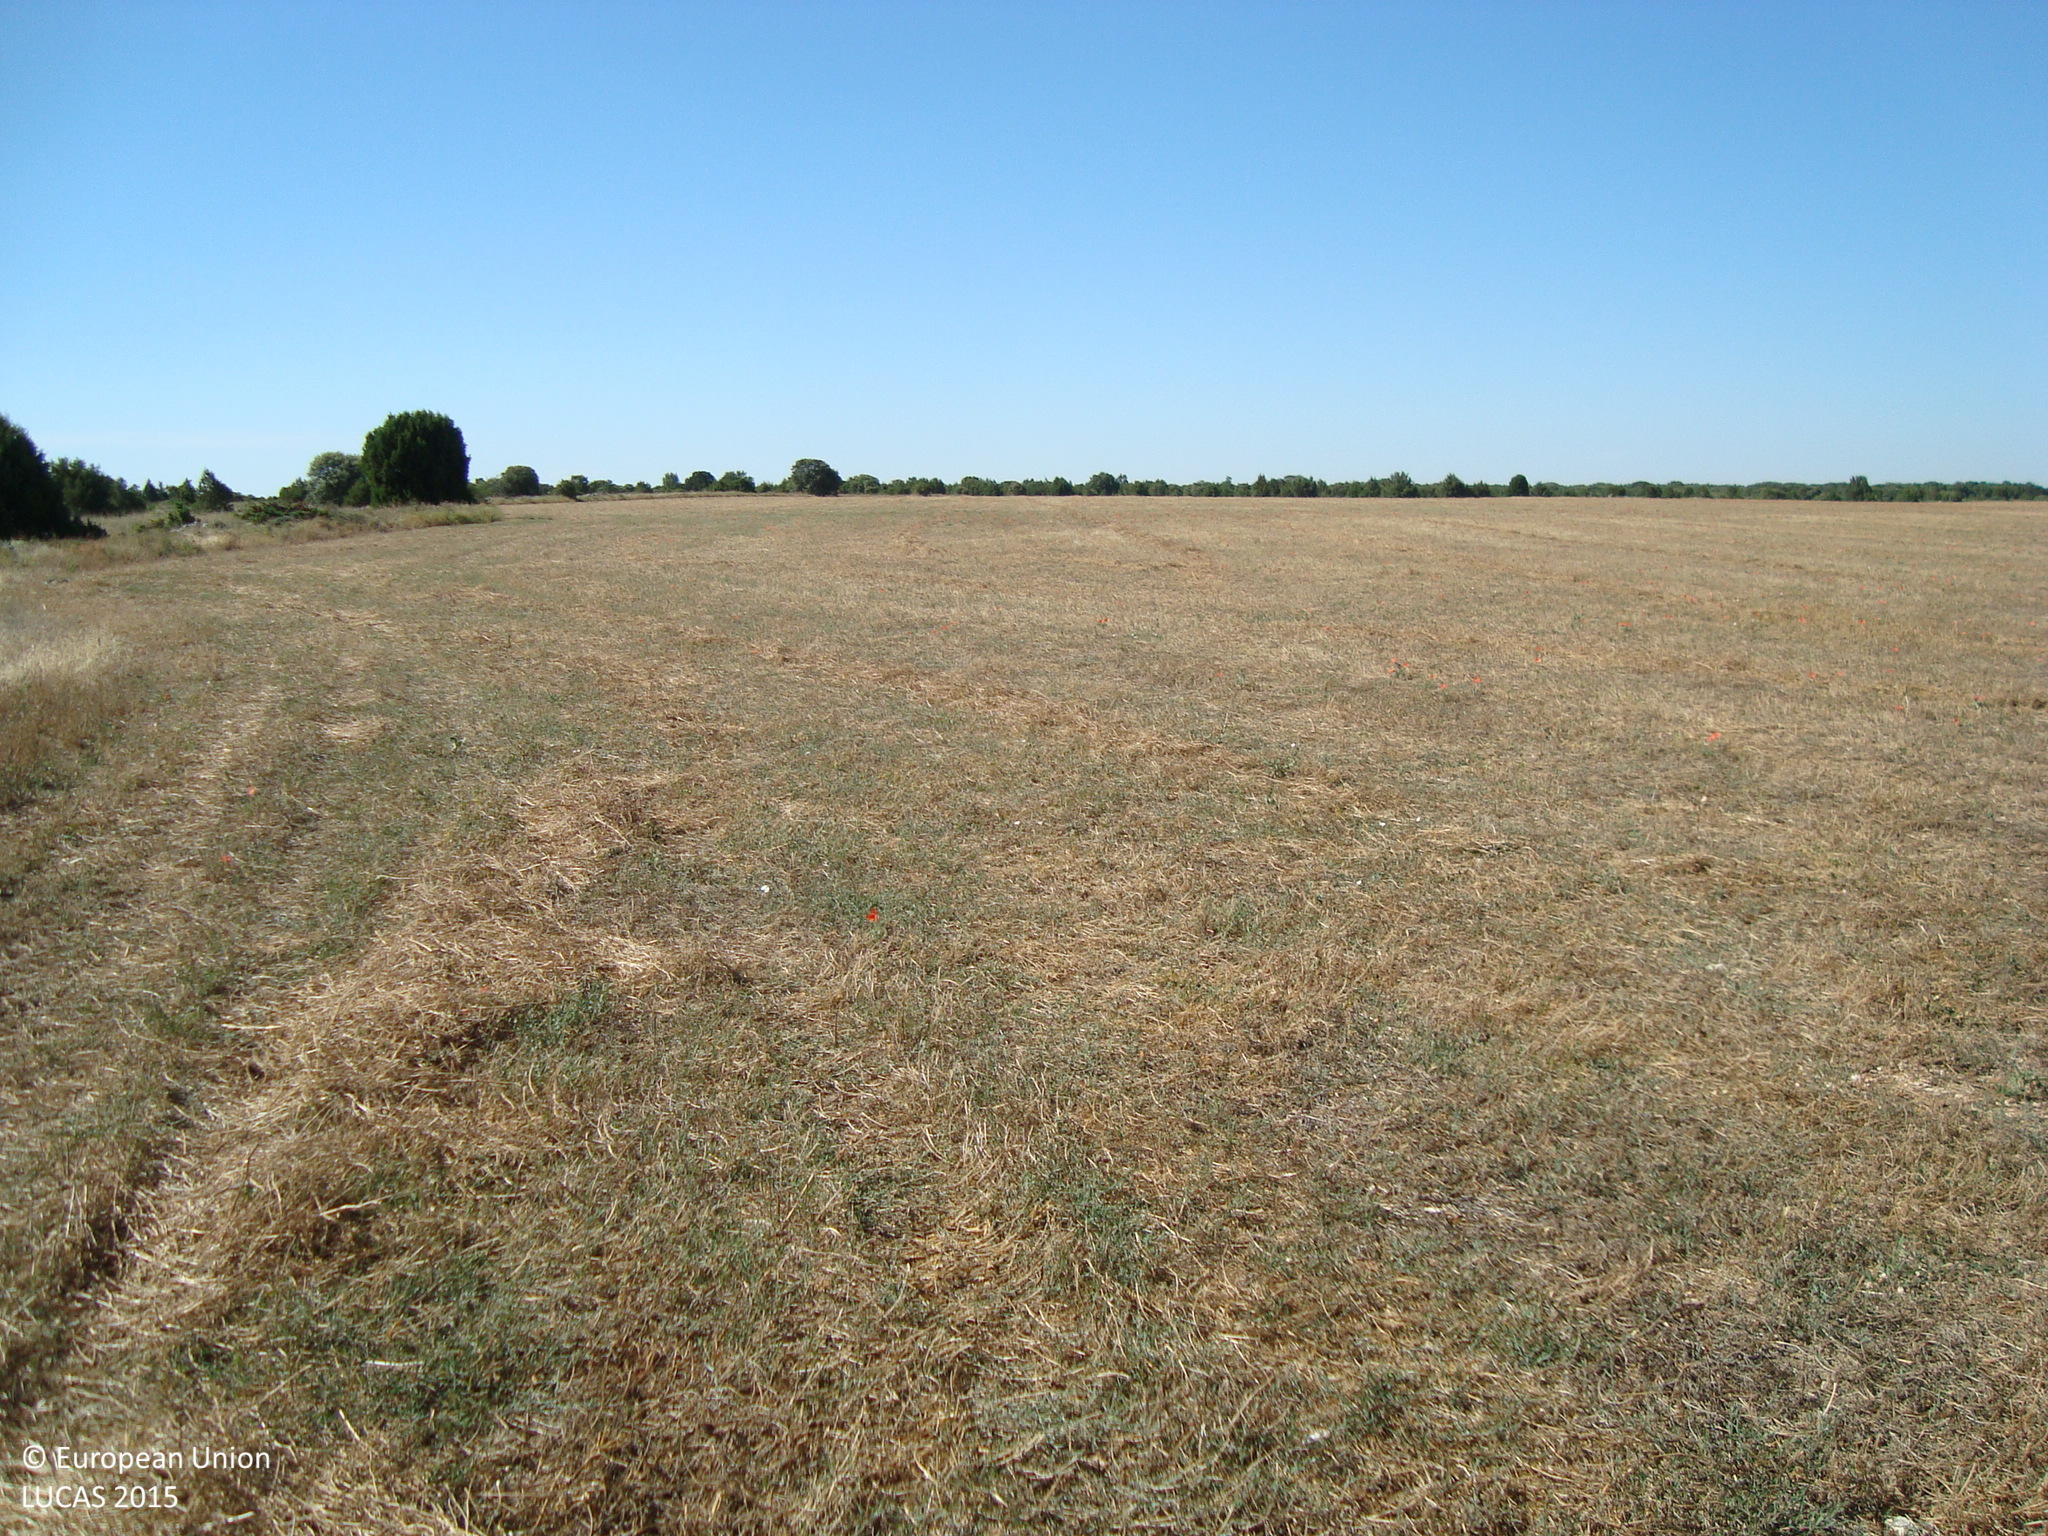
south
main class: Cropland
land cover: Dry pulses
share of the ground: > 75 %
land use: Agriculture (excluding fallow land and kitchen gardens)
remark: Harvested field
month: July
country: ES
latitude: 41.9028
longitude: -4.0808
